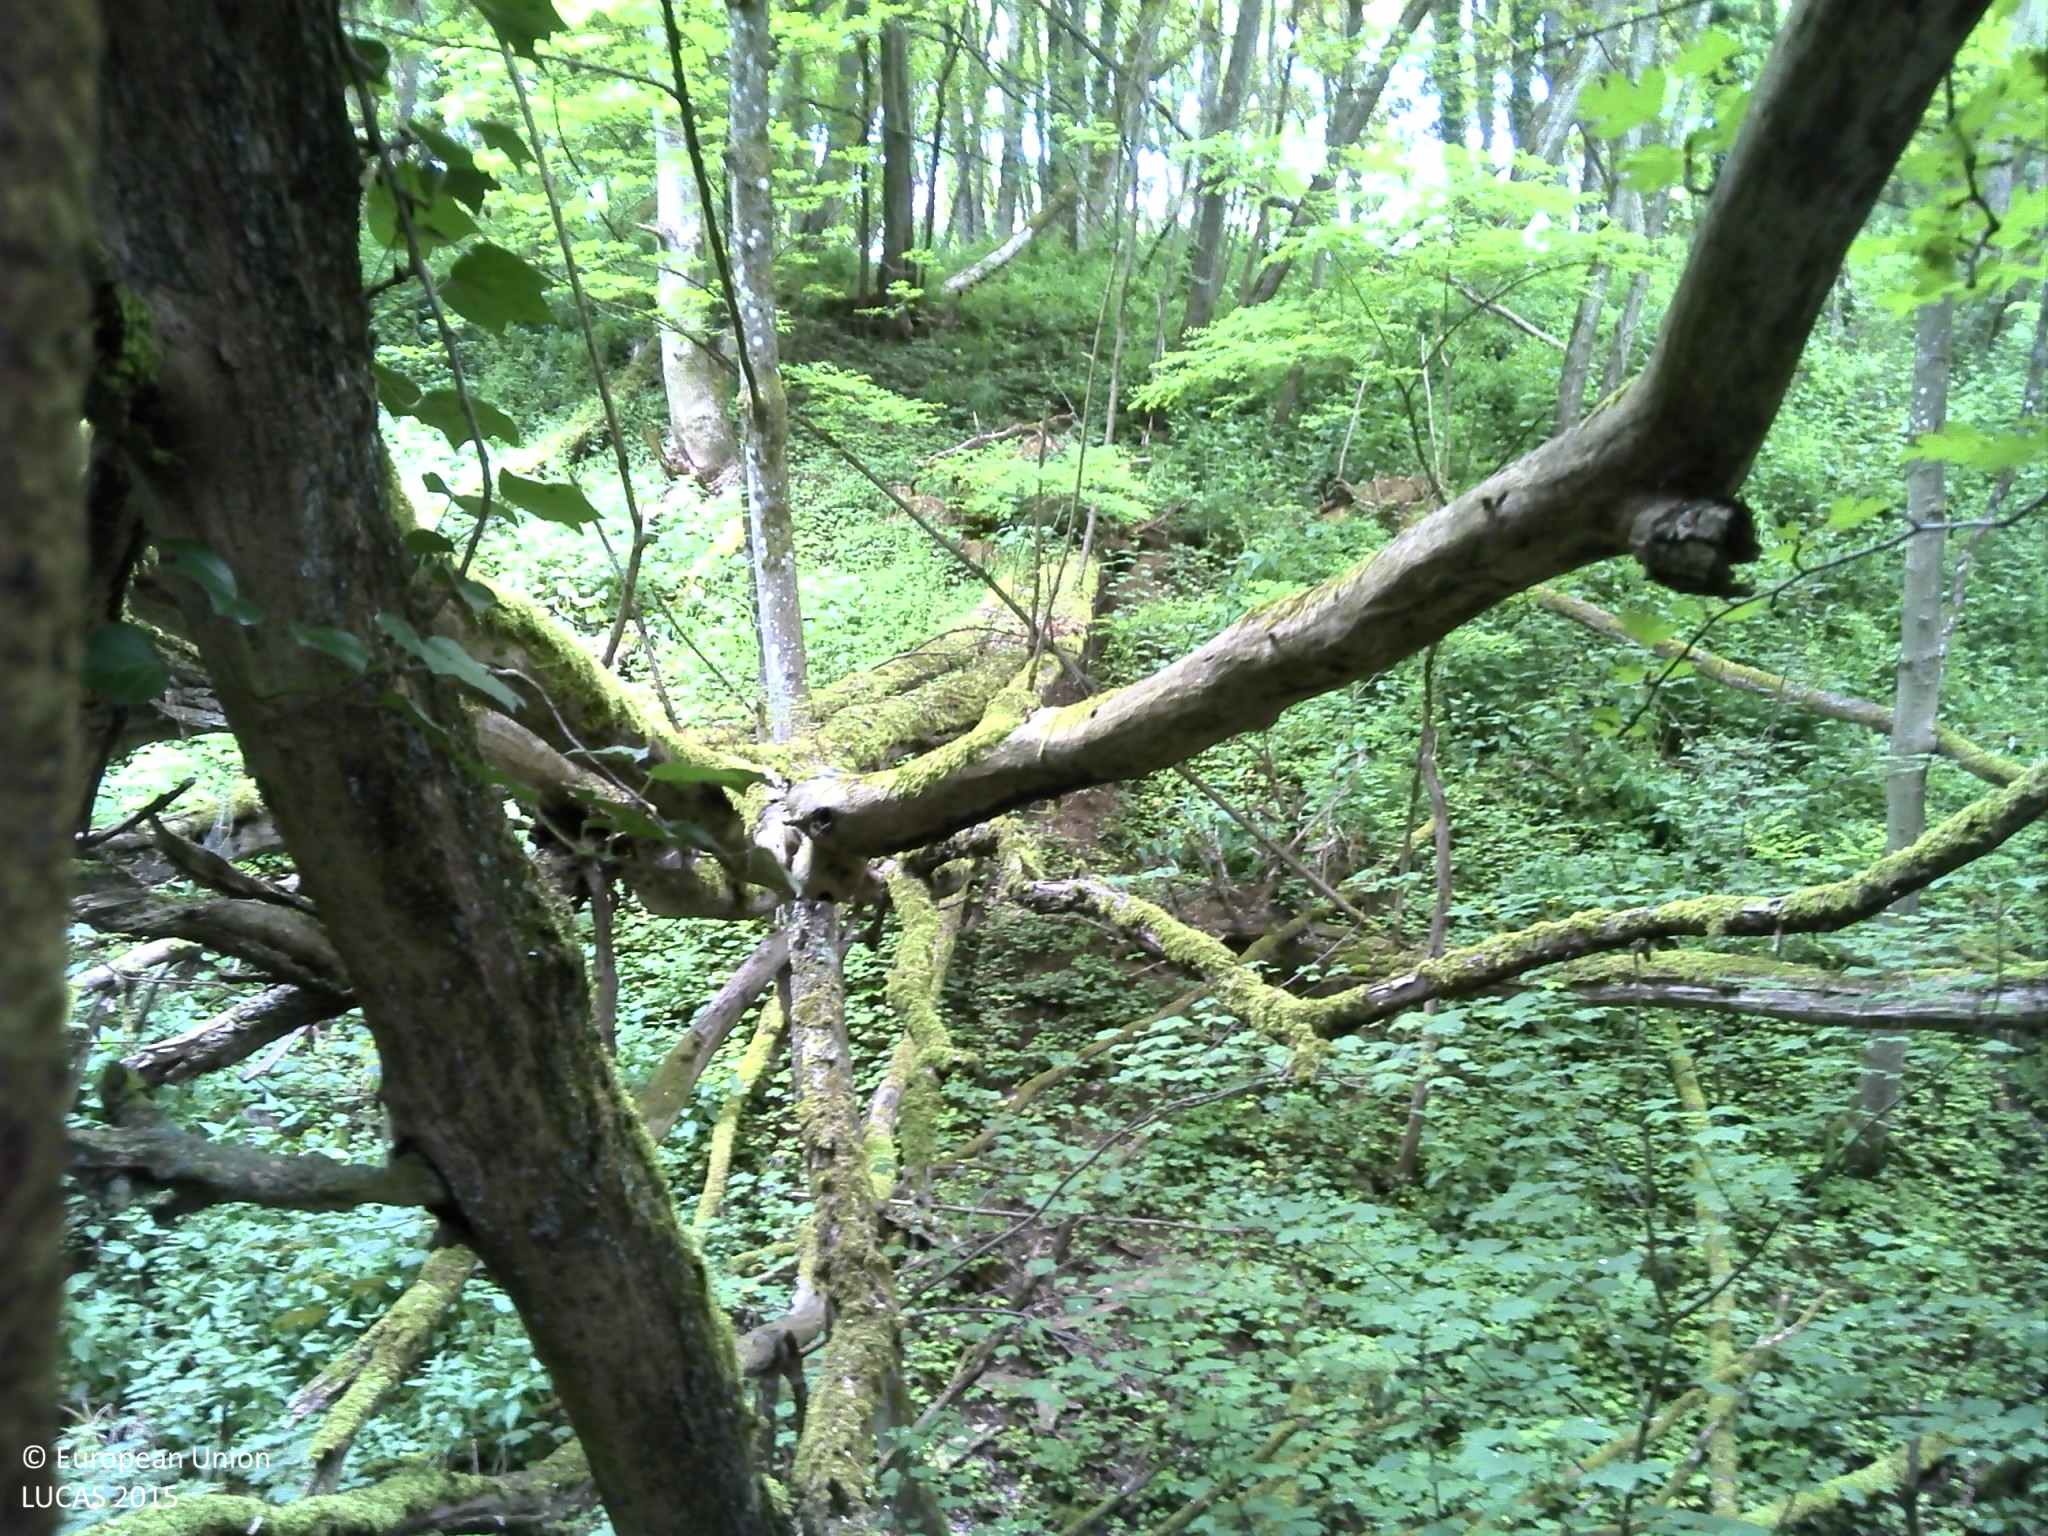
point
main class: Woodland
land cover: Broadleaved woodland
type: mesophytic deciduous forest
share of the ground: > 75 %
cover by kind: broadleaved forest trees 95 %, shrubs 5 %
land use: Semi-natural and natural areas not in use
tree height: > 5 m
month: June
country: FR
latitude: 49.0239
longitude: 6.2391
